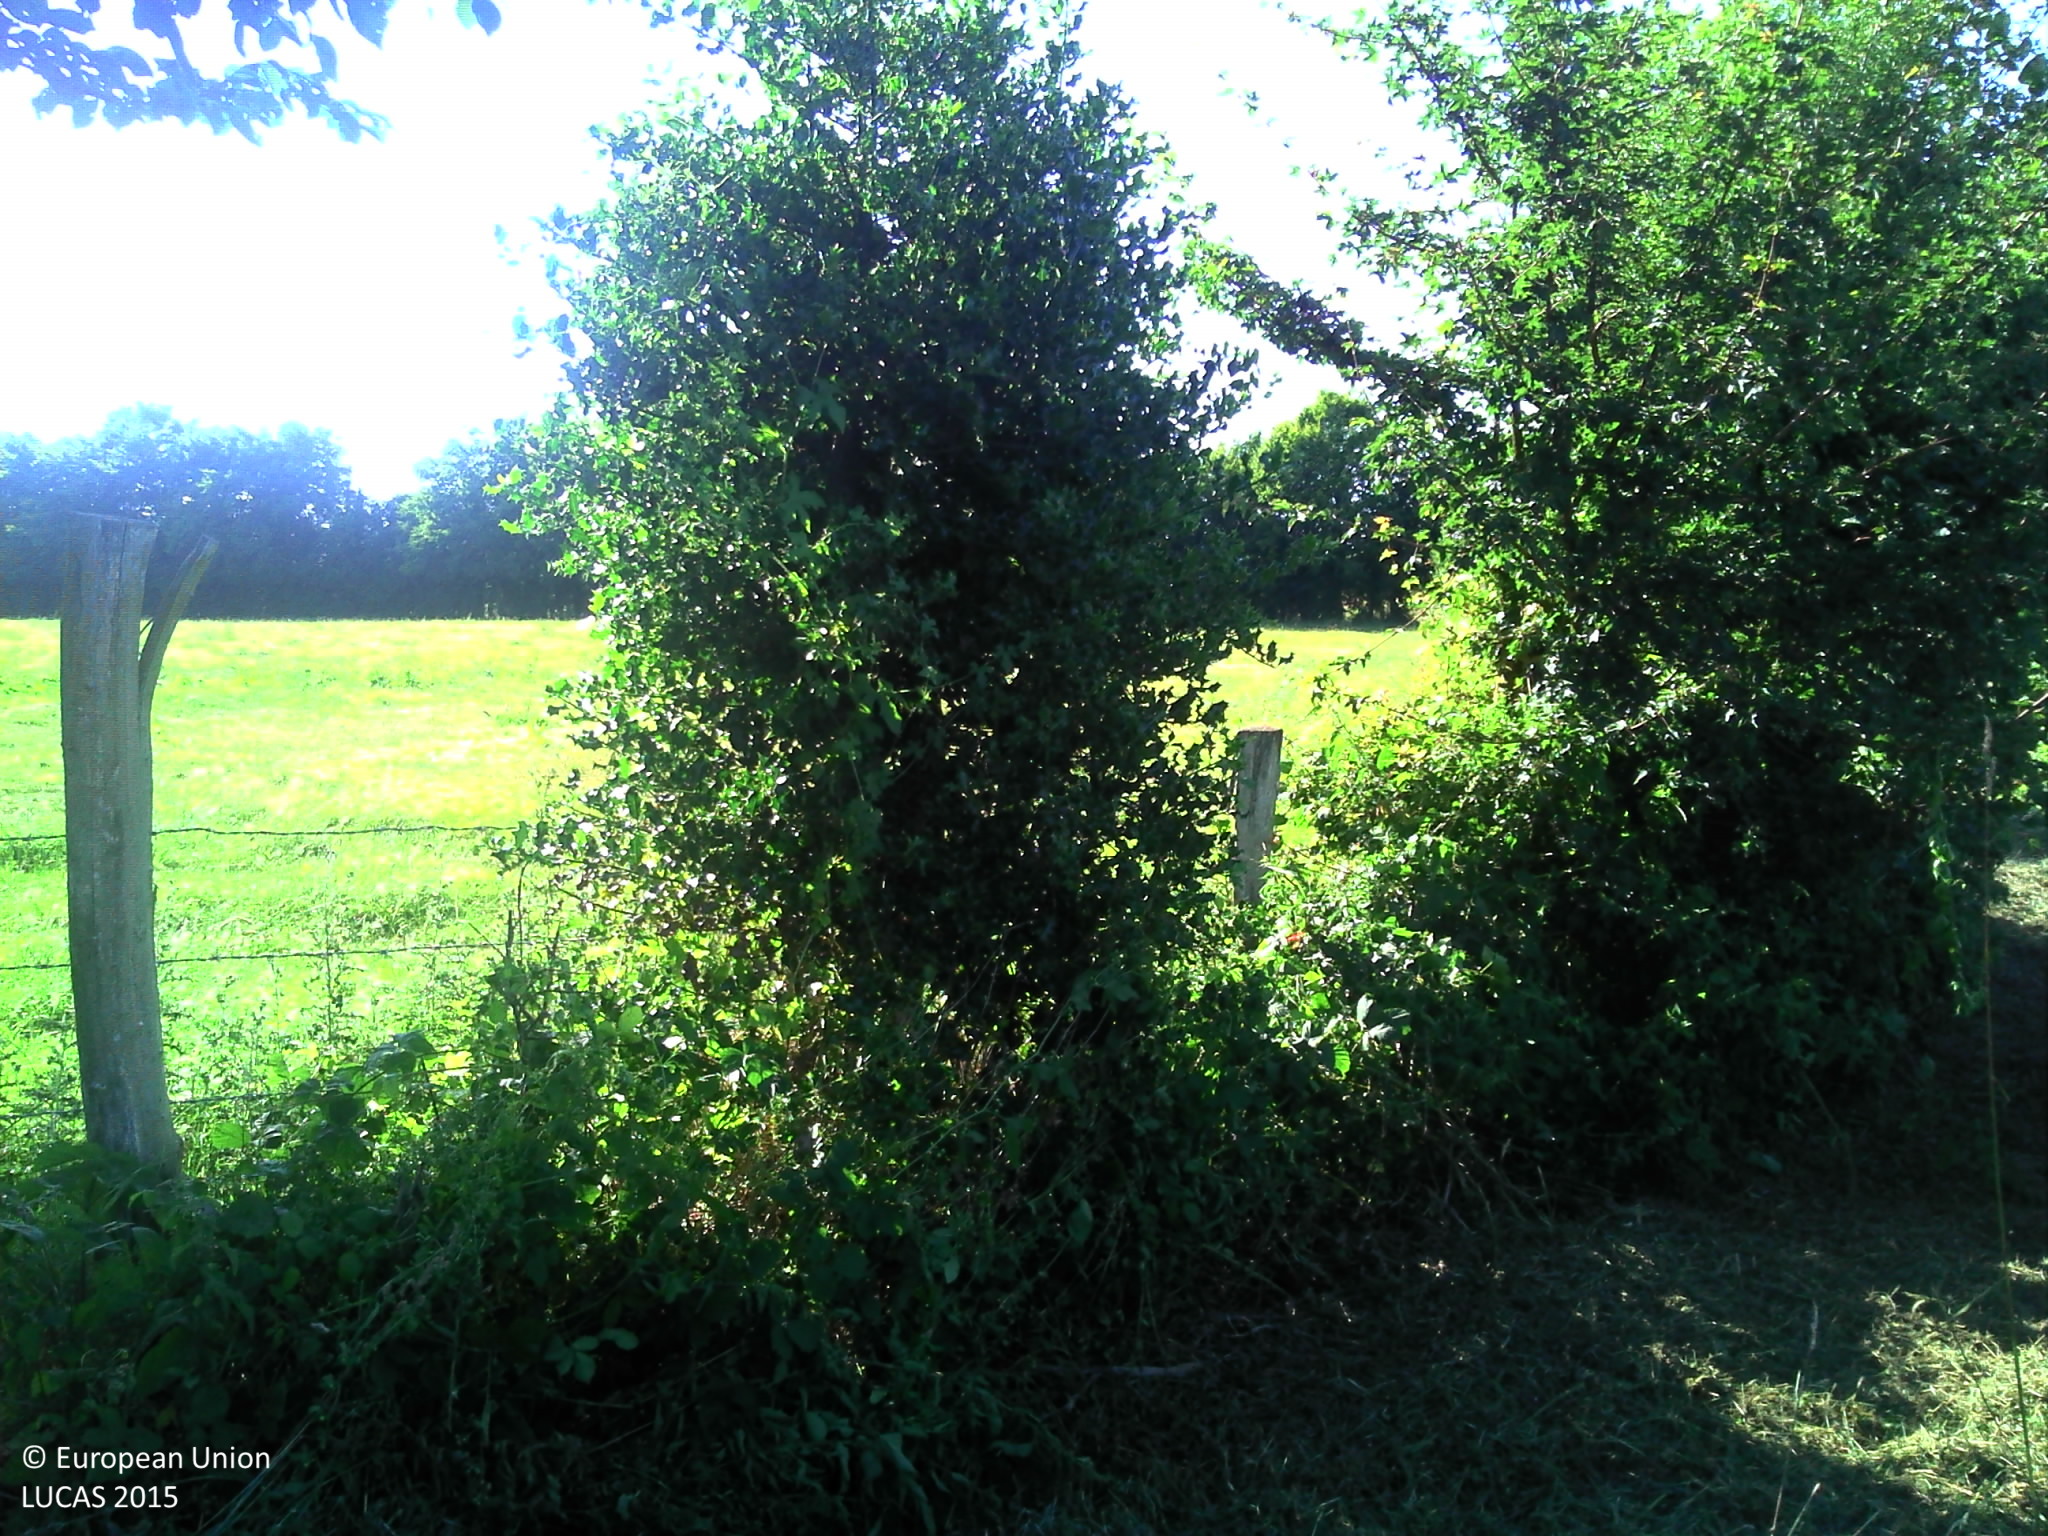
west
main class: Cropland
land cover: Rape and turnip rape
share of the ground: > 75 %
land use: Agriculture (excluding fallow land and kitchen gardens)
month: July
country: FR
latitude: 49.0775
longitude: 0.6799
